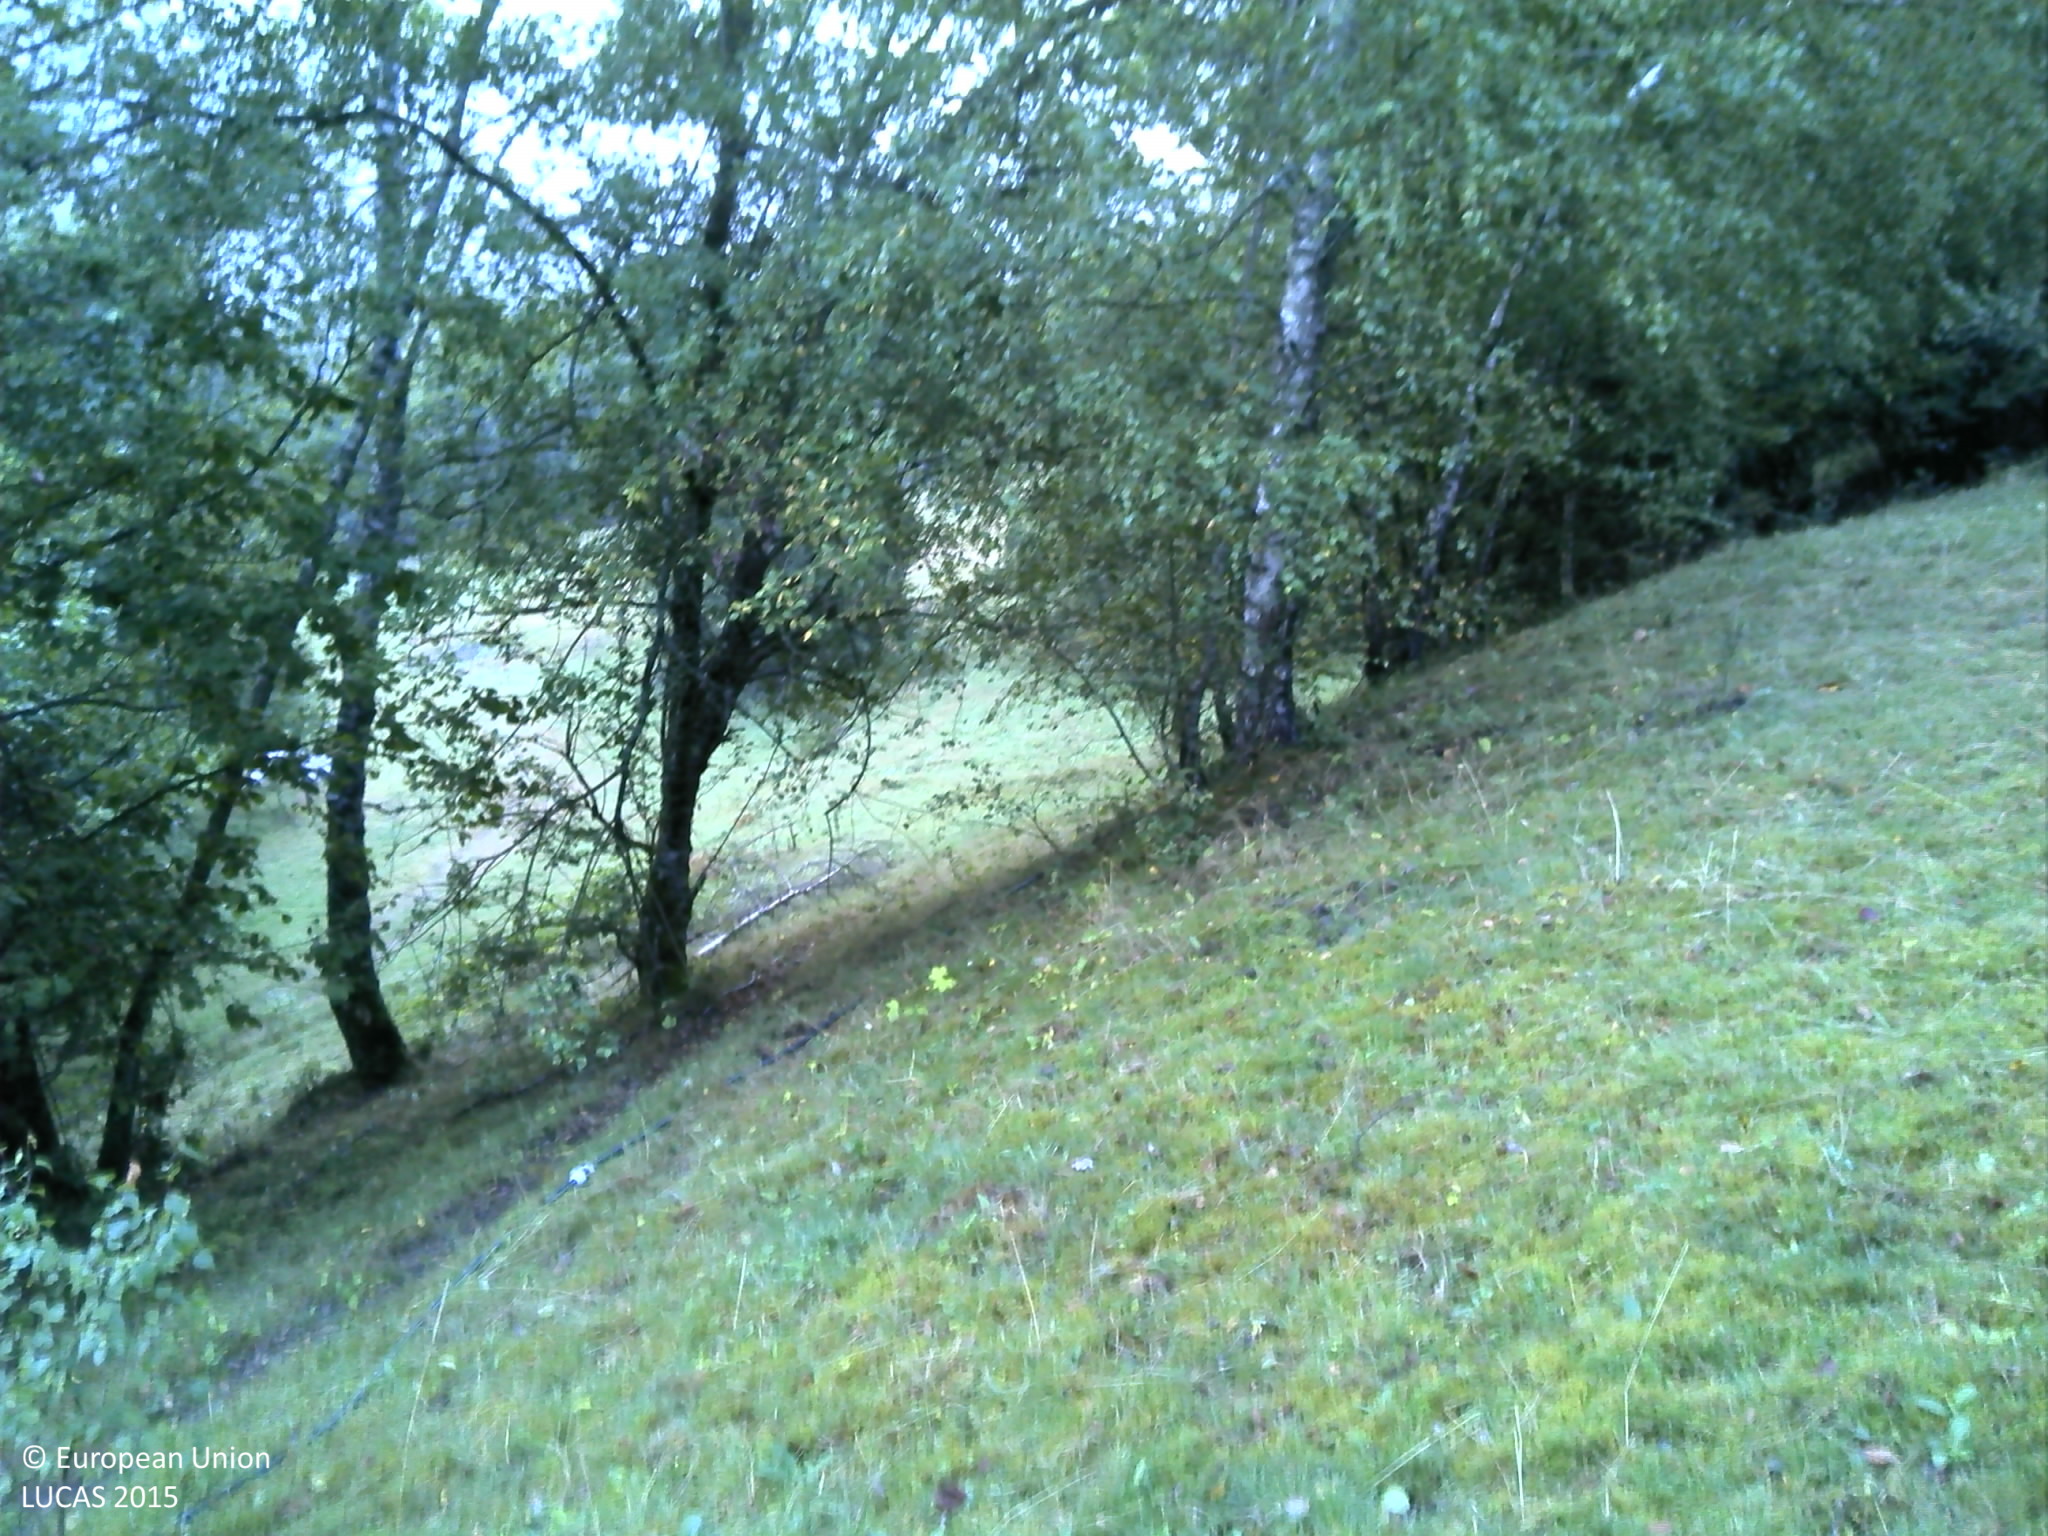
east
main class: Grassland
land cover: Grassland with sparse tree/shrub cover
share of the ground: > 75 %
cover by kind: herbaceous plants 95 %, broadleaved forest trees 5 %
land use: Agriculture (excluding fallow land and kitchen gardens)
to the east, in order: Grassland with sparse tree/shrub cover; Fences; Lines of trees; Artificial constructions in urban areas; Grassland with sparse tree/shrub cover; Broadleaved woodland
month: August
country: FR
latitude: 47.8539
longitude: 6.8338
